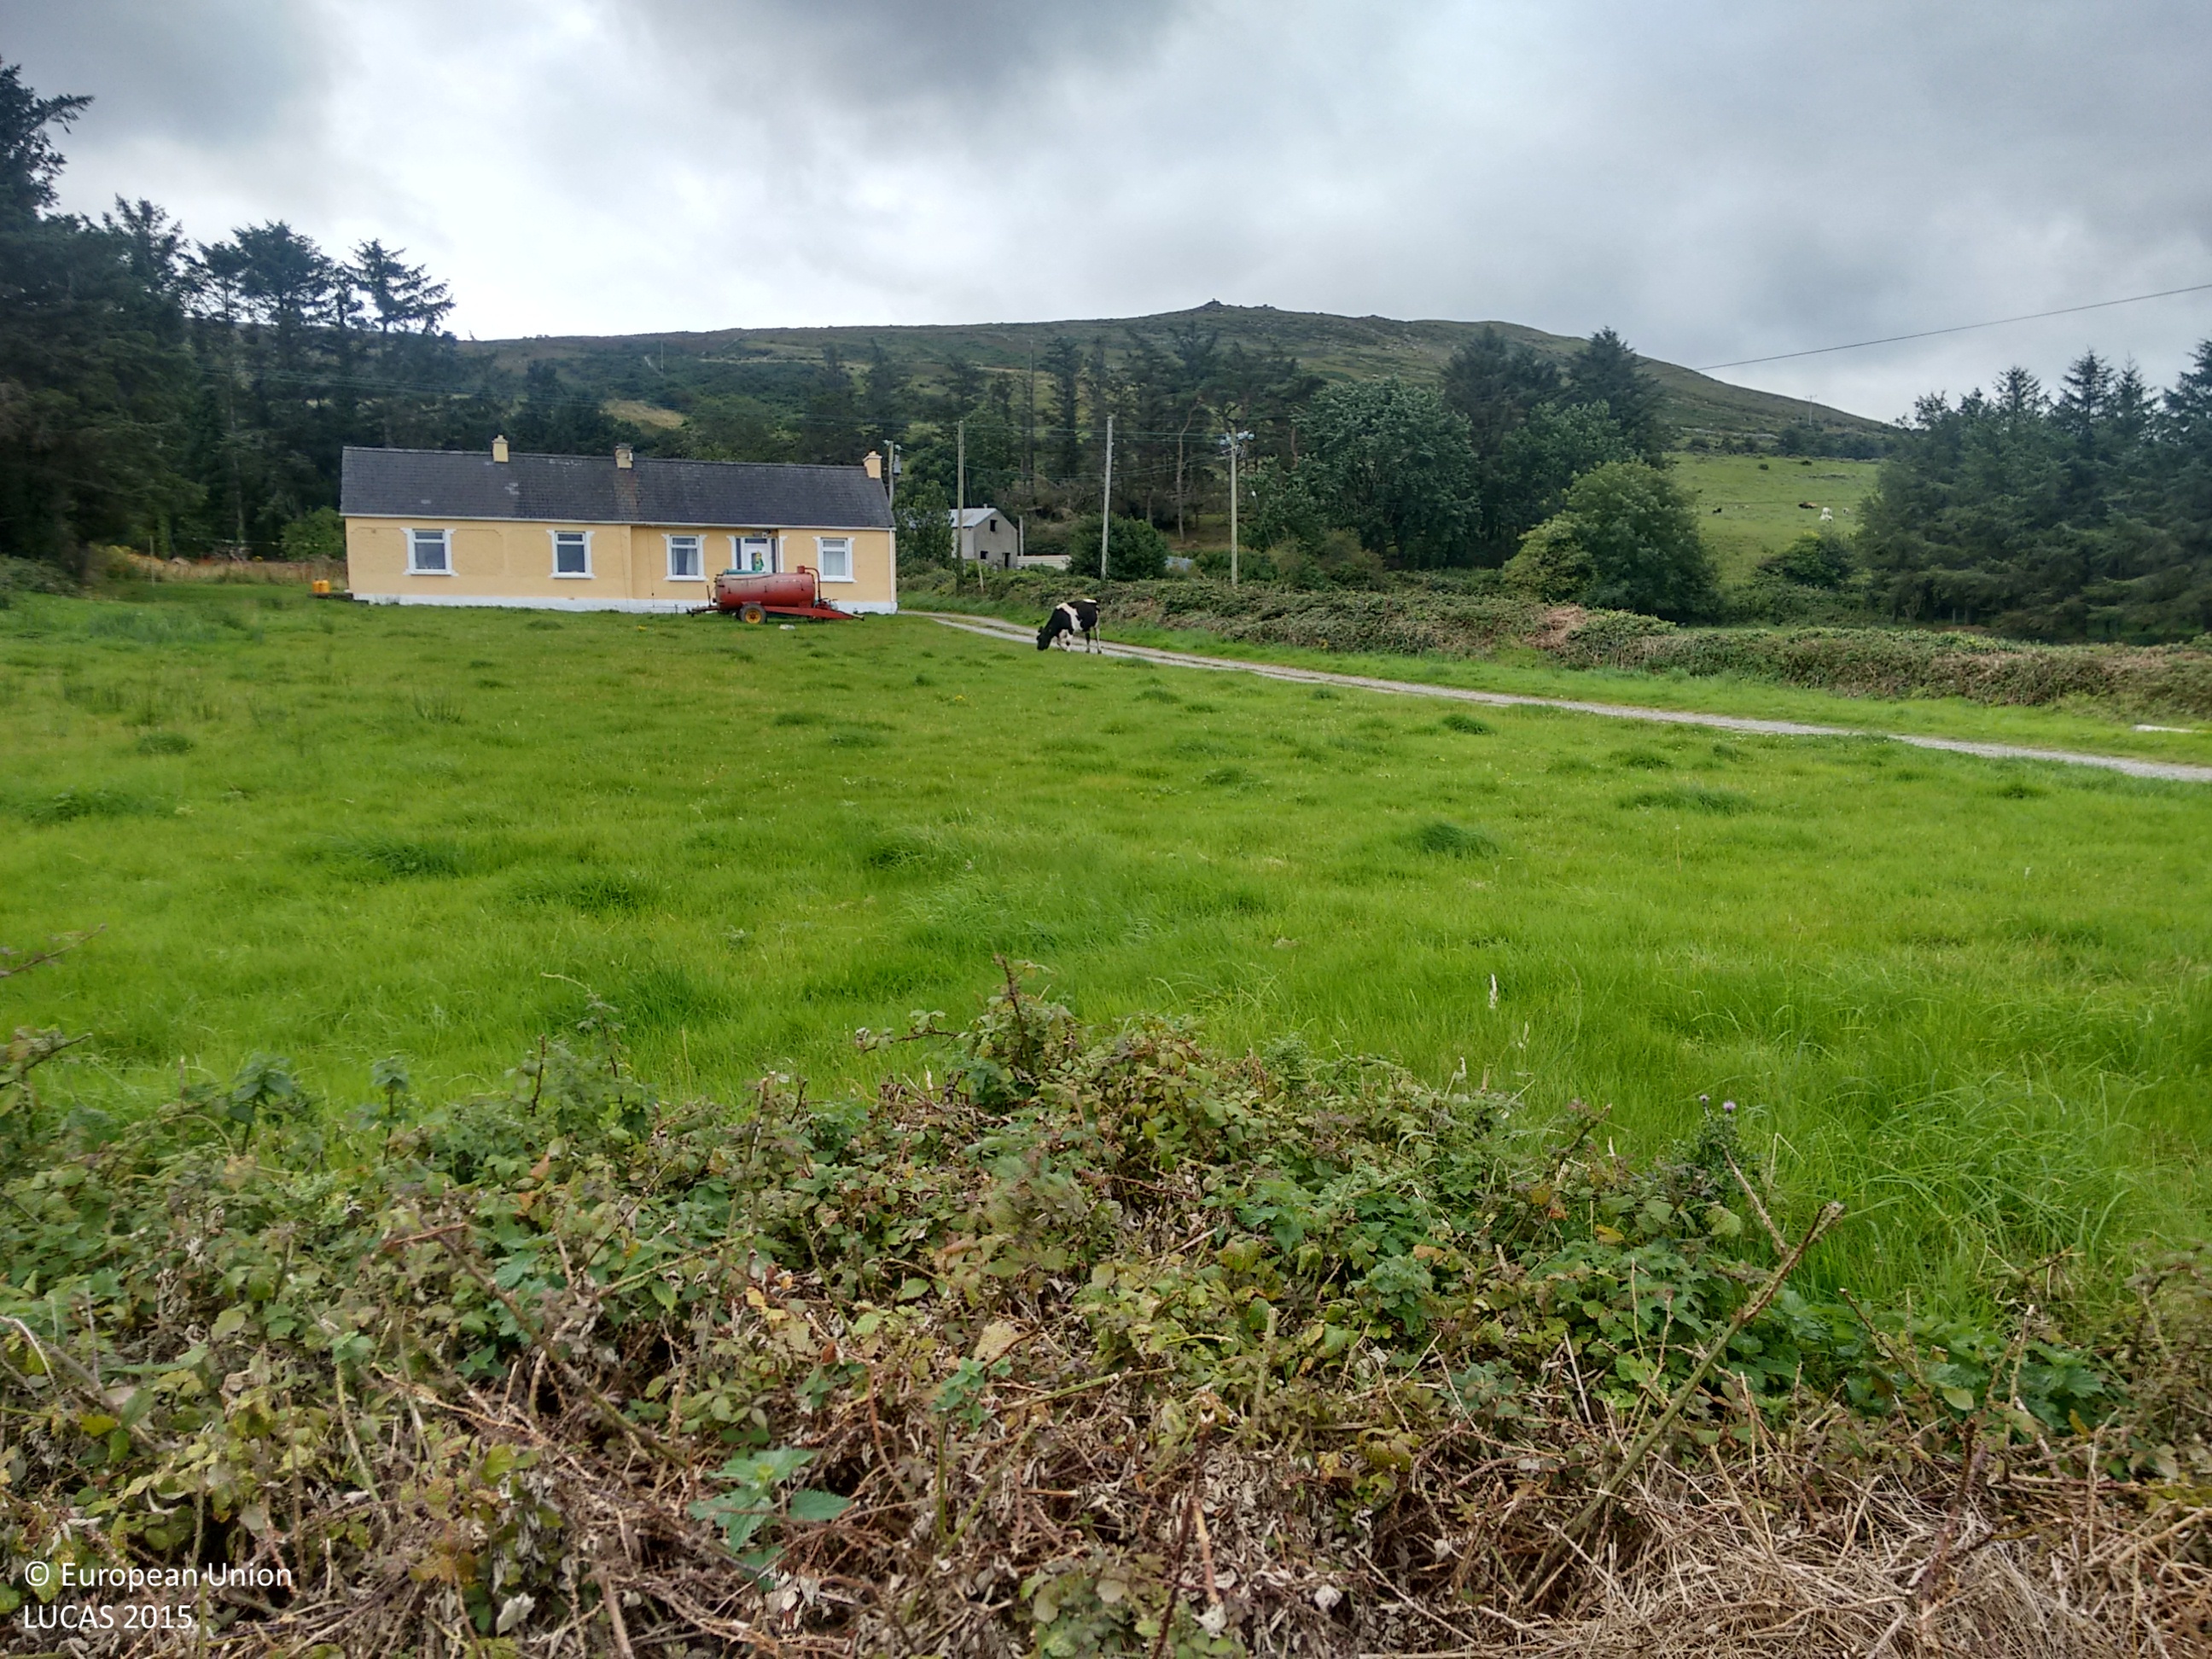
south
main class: Grassland
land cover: Grassland without tree/shrub cover
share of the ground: > 75 %
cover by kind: herbaceous plants 85 %, unconsolidated bare surface 10 %, shrubs 5 %
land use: Agriculture (excluding fallow land and kitchen gardens)
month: September
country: IE
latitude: 52.2282
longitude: -9.8820
